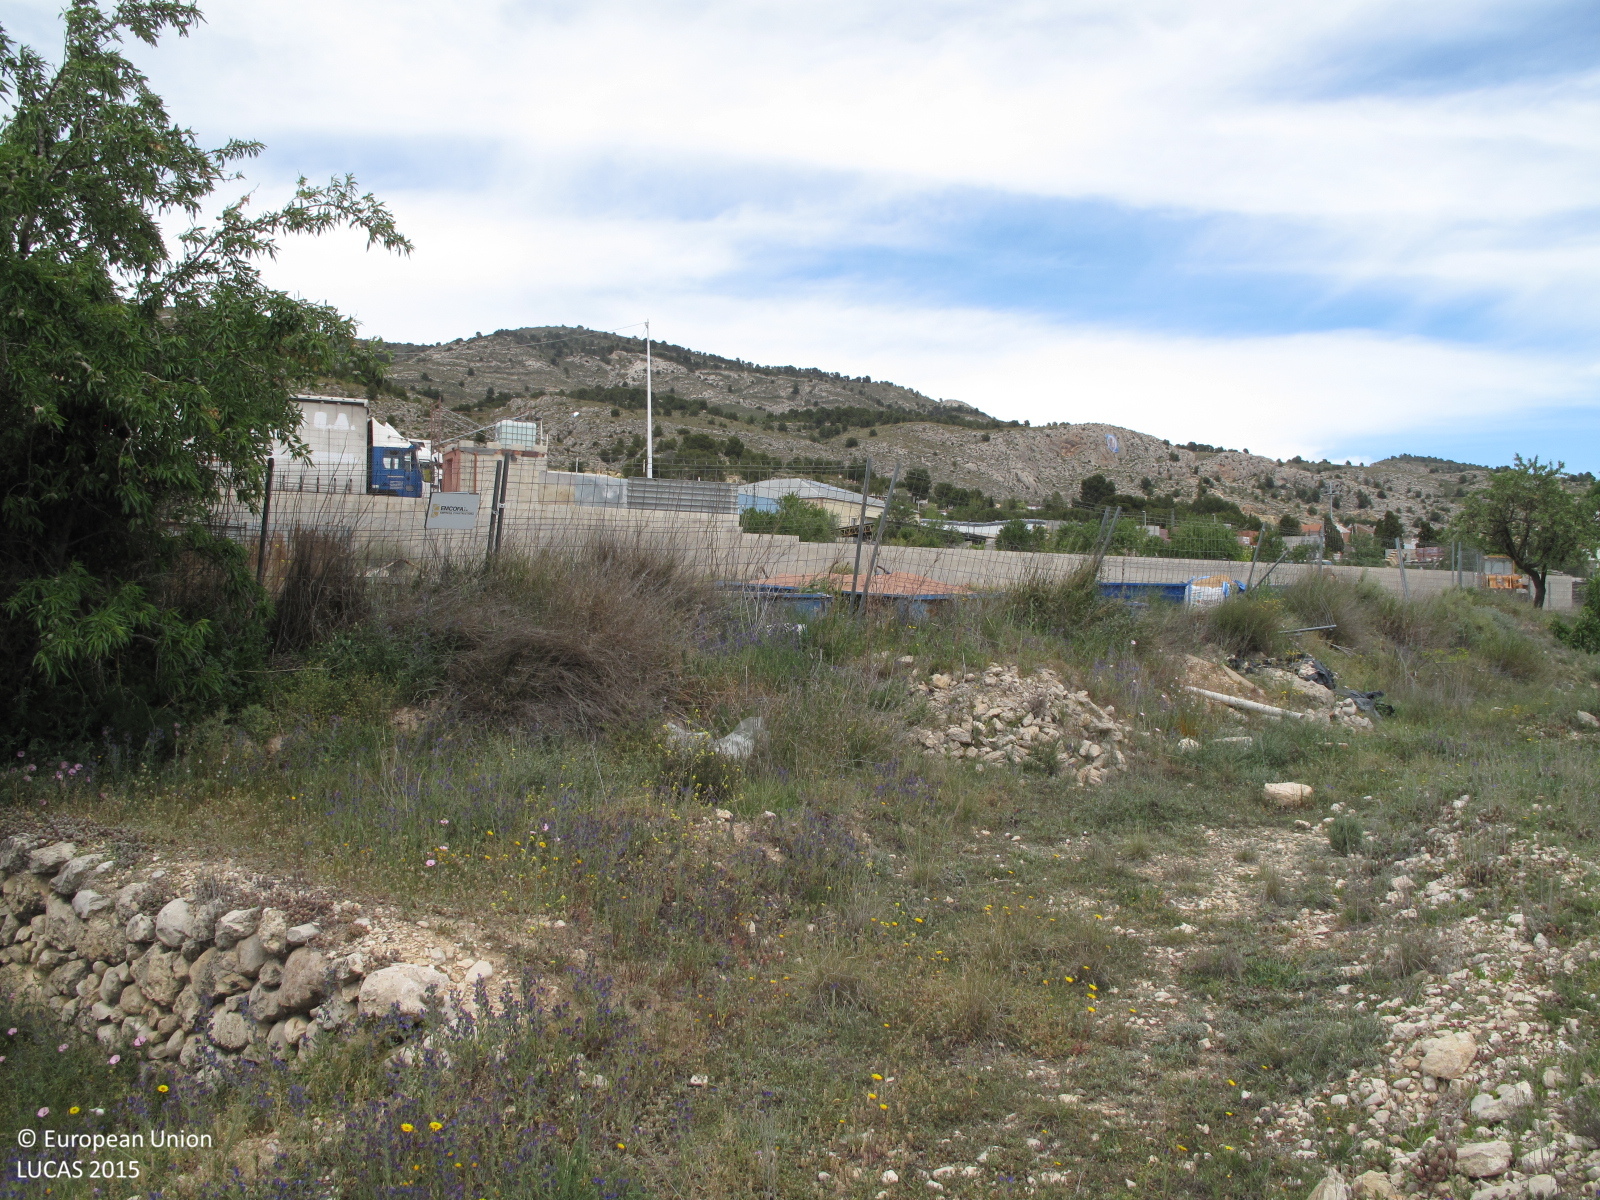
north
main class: Cropland
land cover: Olive groves
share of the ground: < 10 %
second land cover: Nuts trees
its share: < 10 %
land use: Agriculture (excluding fallow land and kitchen gardens)
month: April
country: ES
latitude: 38.6239
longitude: -0.6829
